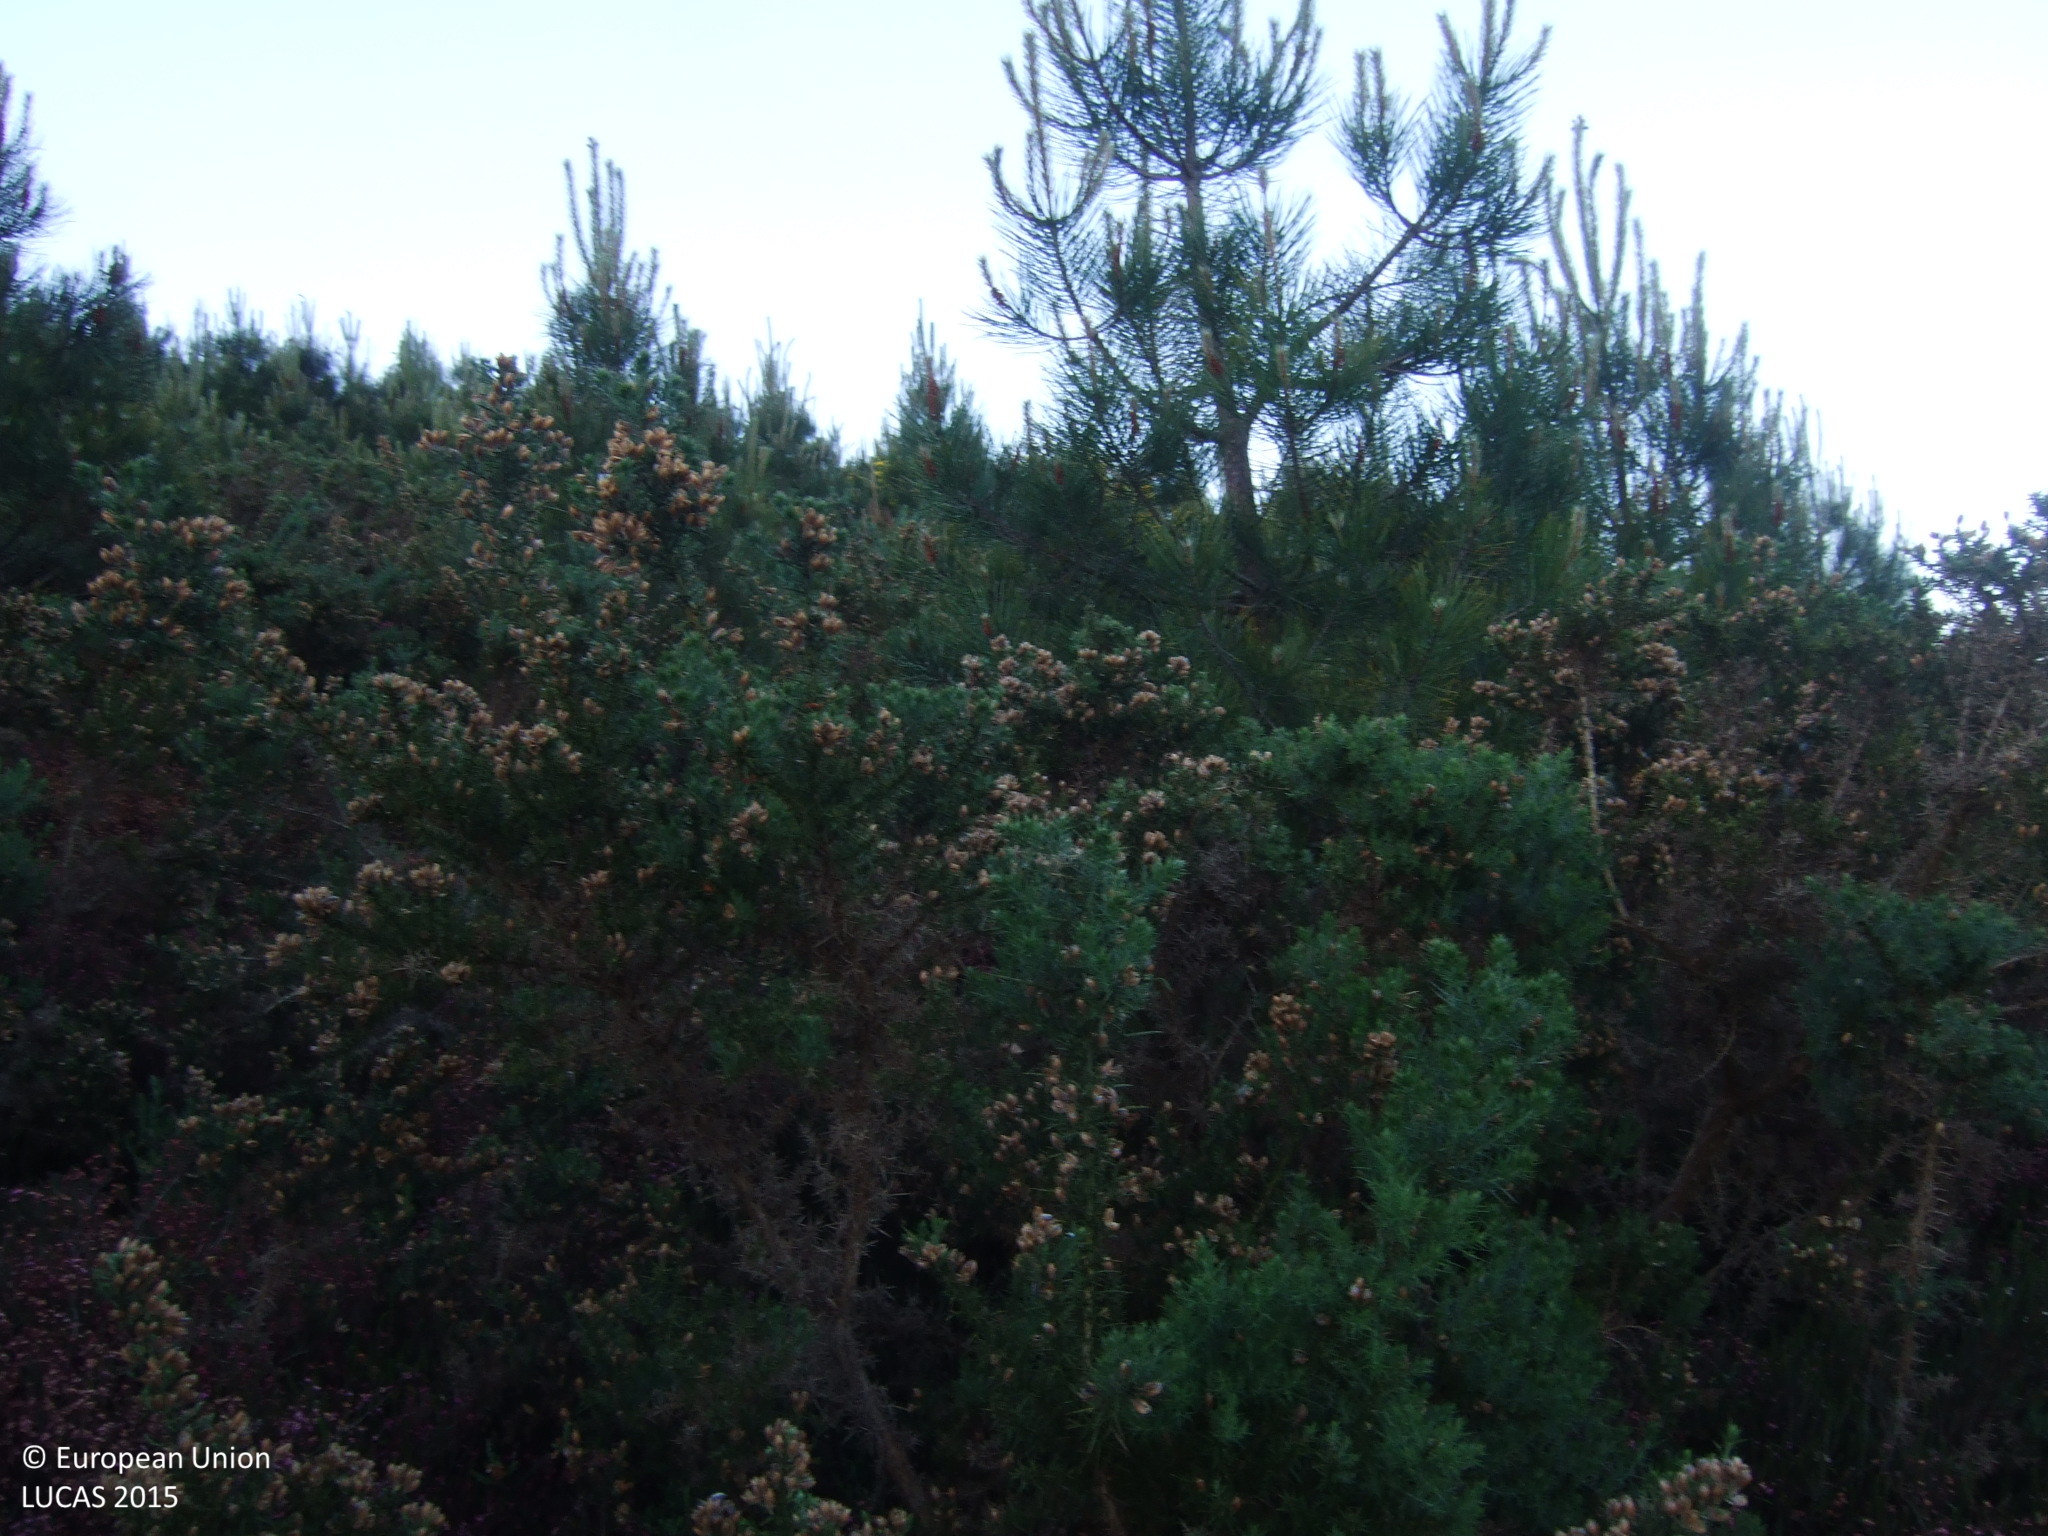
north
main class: Woodland
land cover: Pine dominated coniferous woodland
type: exotic forest
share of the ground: 10 - 25 %
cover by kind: shrubs 80 %, coniferous forest trees 20 %
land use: Forestry
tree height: < 5 m
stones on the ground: > 50 %
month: May
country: ES
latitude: 42.7146
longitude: -7.3203
